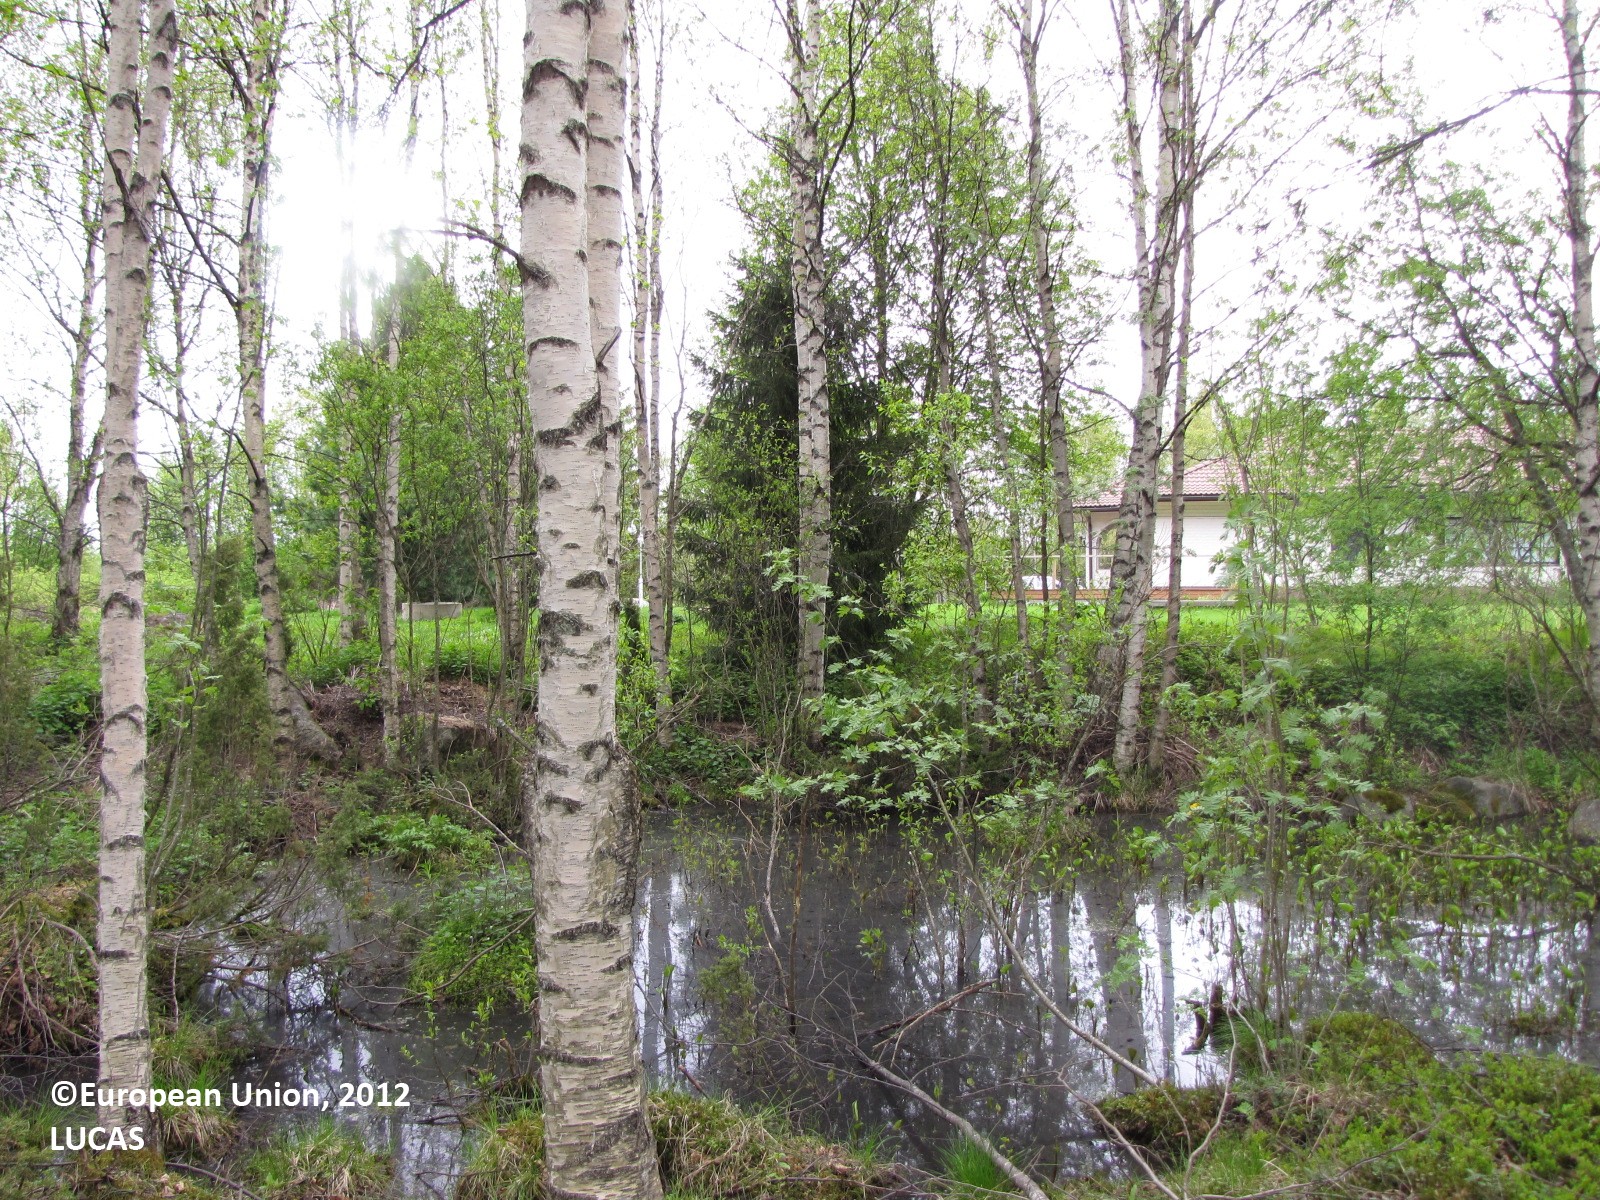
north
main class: Woodland
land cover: Broadleaved woodland
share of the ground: > 75 %
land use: Forestry
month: June
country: FI
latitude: 65.8369
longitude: 24.2134
